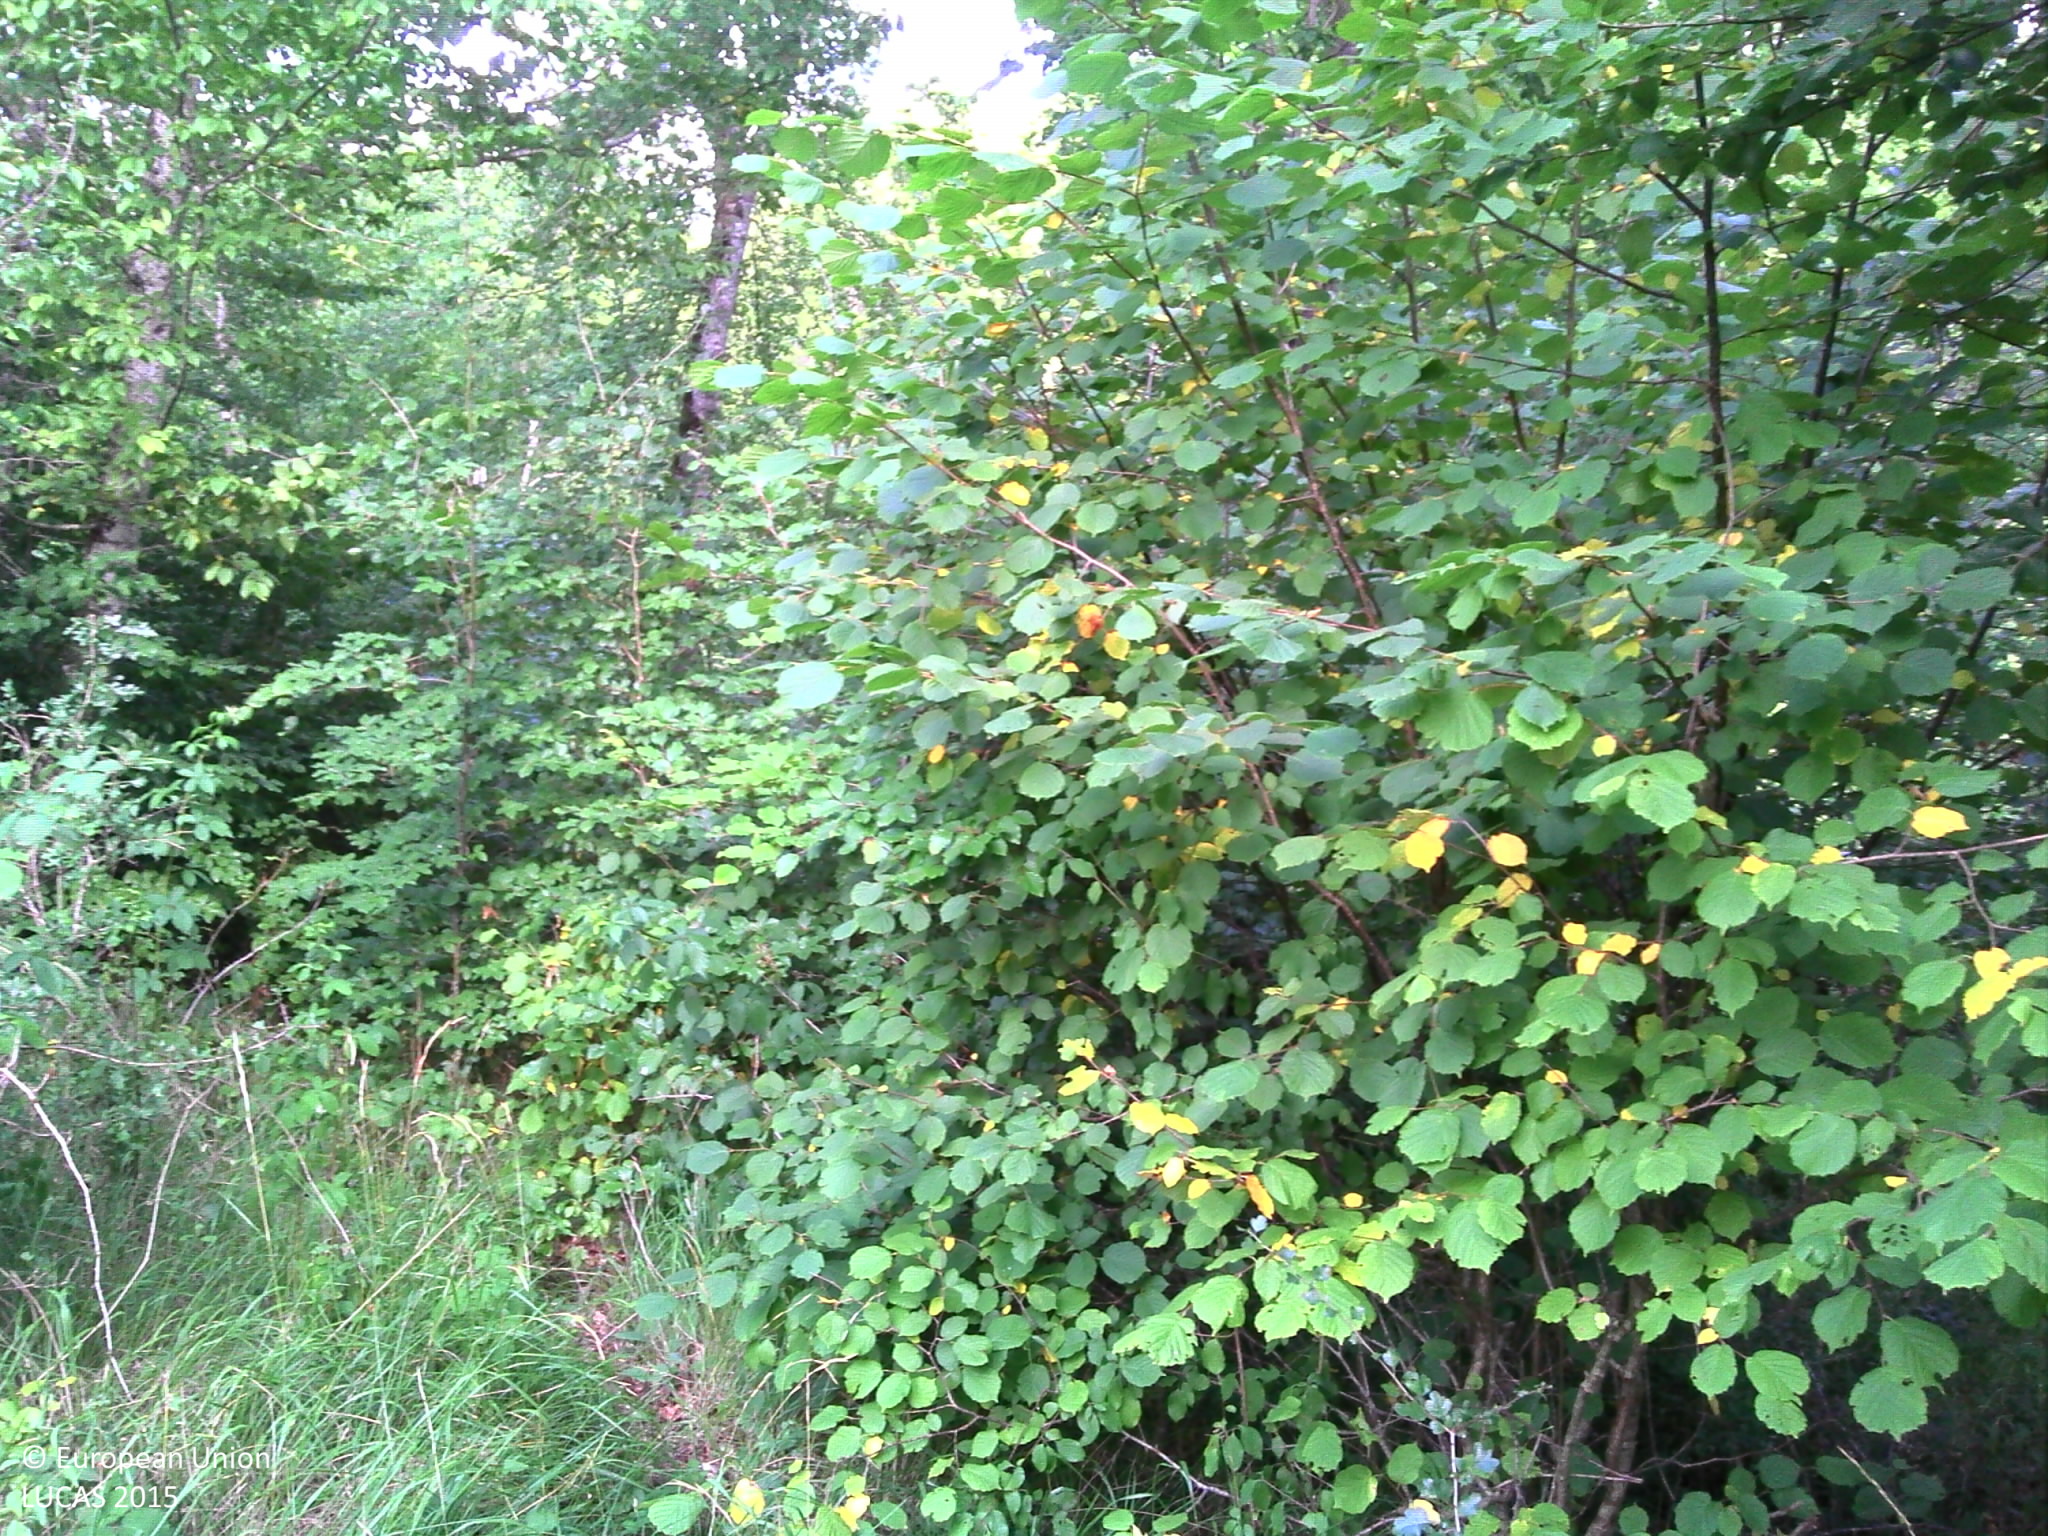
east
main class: Woodland
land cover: Broadleaved woodland
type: beech forest
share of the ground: > 75 %
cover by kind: broadleaved forest trees 80 %, herbaceous plants 15 %, lichens and mosses 5 %
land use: Forestry
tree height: > 5 m
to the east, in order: Broadleaved woodland; Grass margins; Paved roads, cycling and walking lanes; Grass margins; Broadleaved woodland
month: July
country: FR
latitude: 48.1765
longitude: 4.8748
